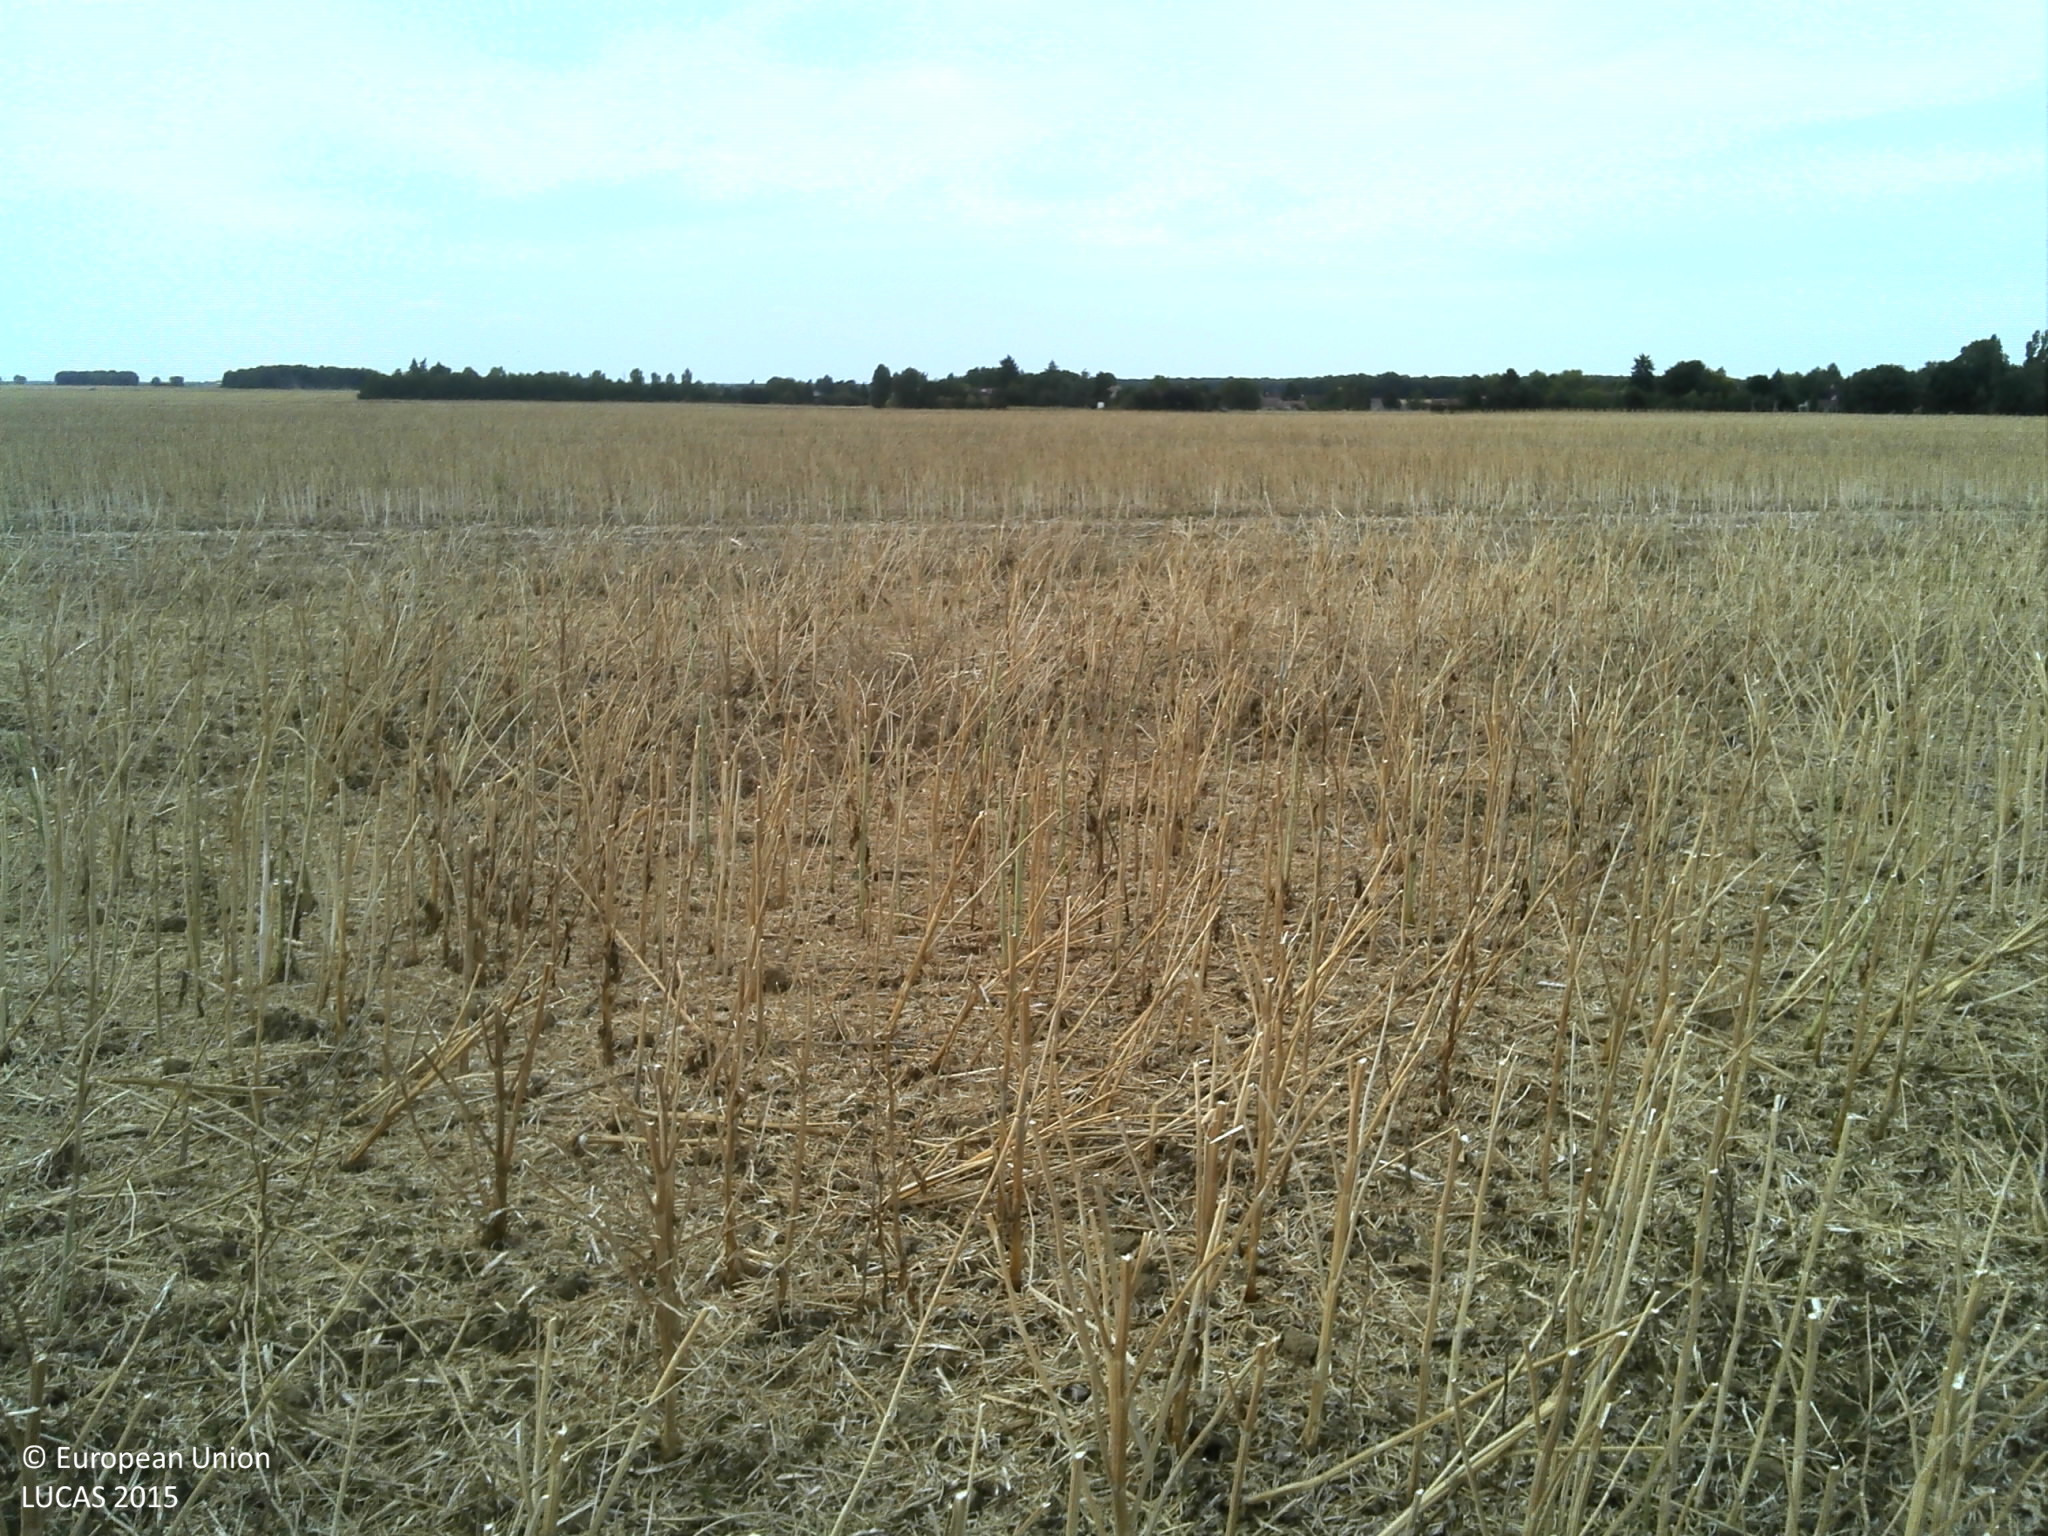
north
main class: Cropland
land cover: Rape and turnip rape
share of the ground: 25 - 50 %
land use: Agriculture (excluding fallow land and kitchen gardens)
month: August
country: FR
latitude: 48.5916
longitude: 1.8641
